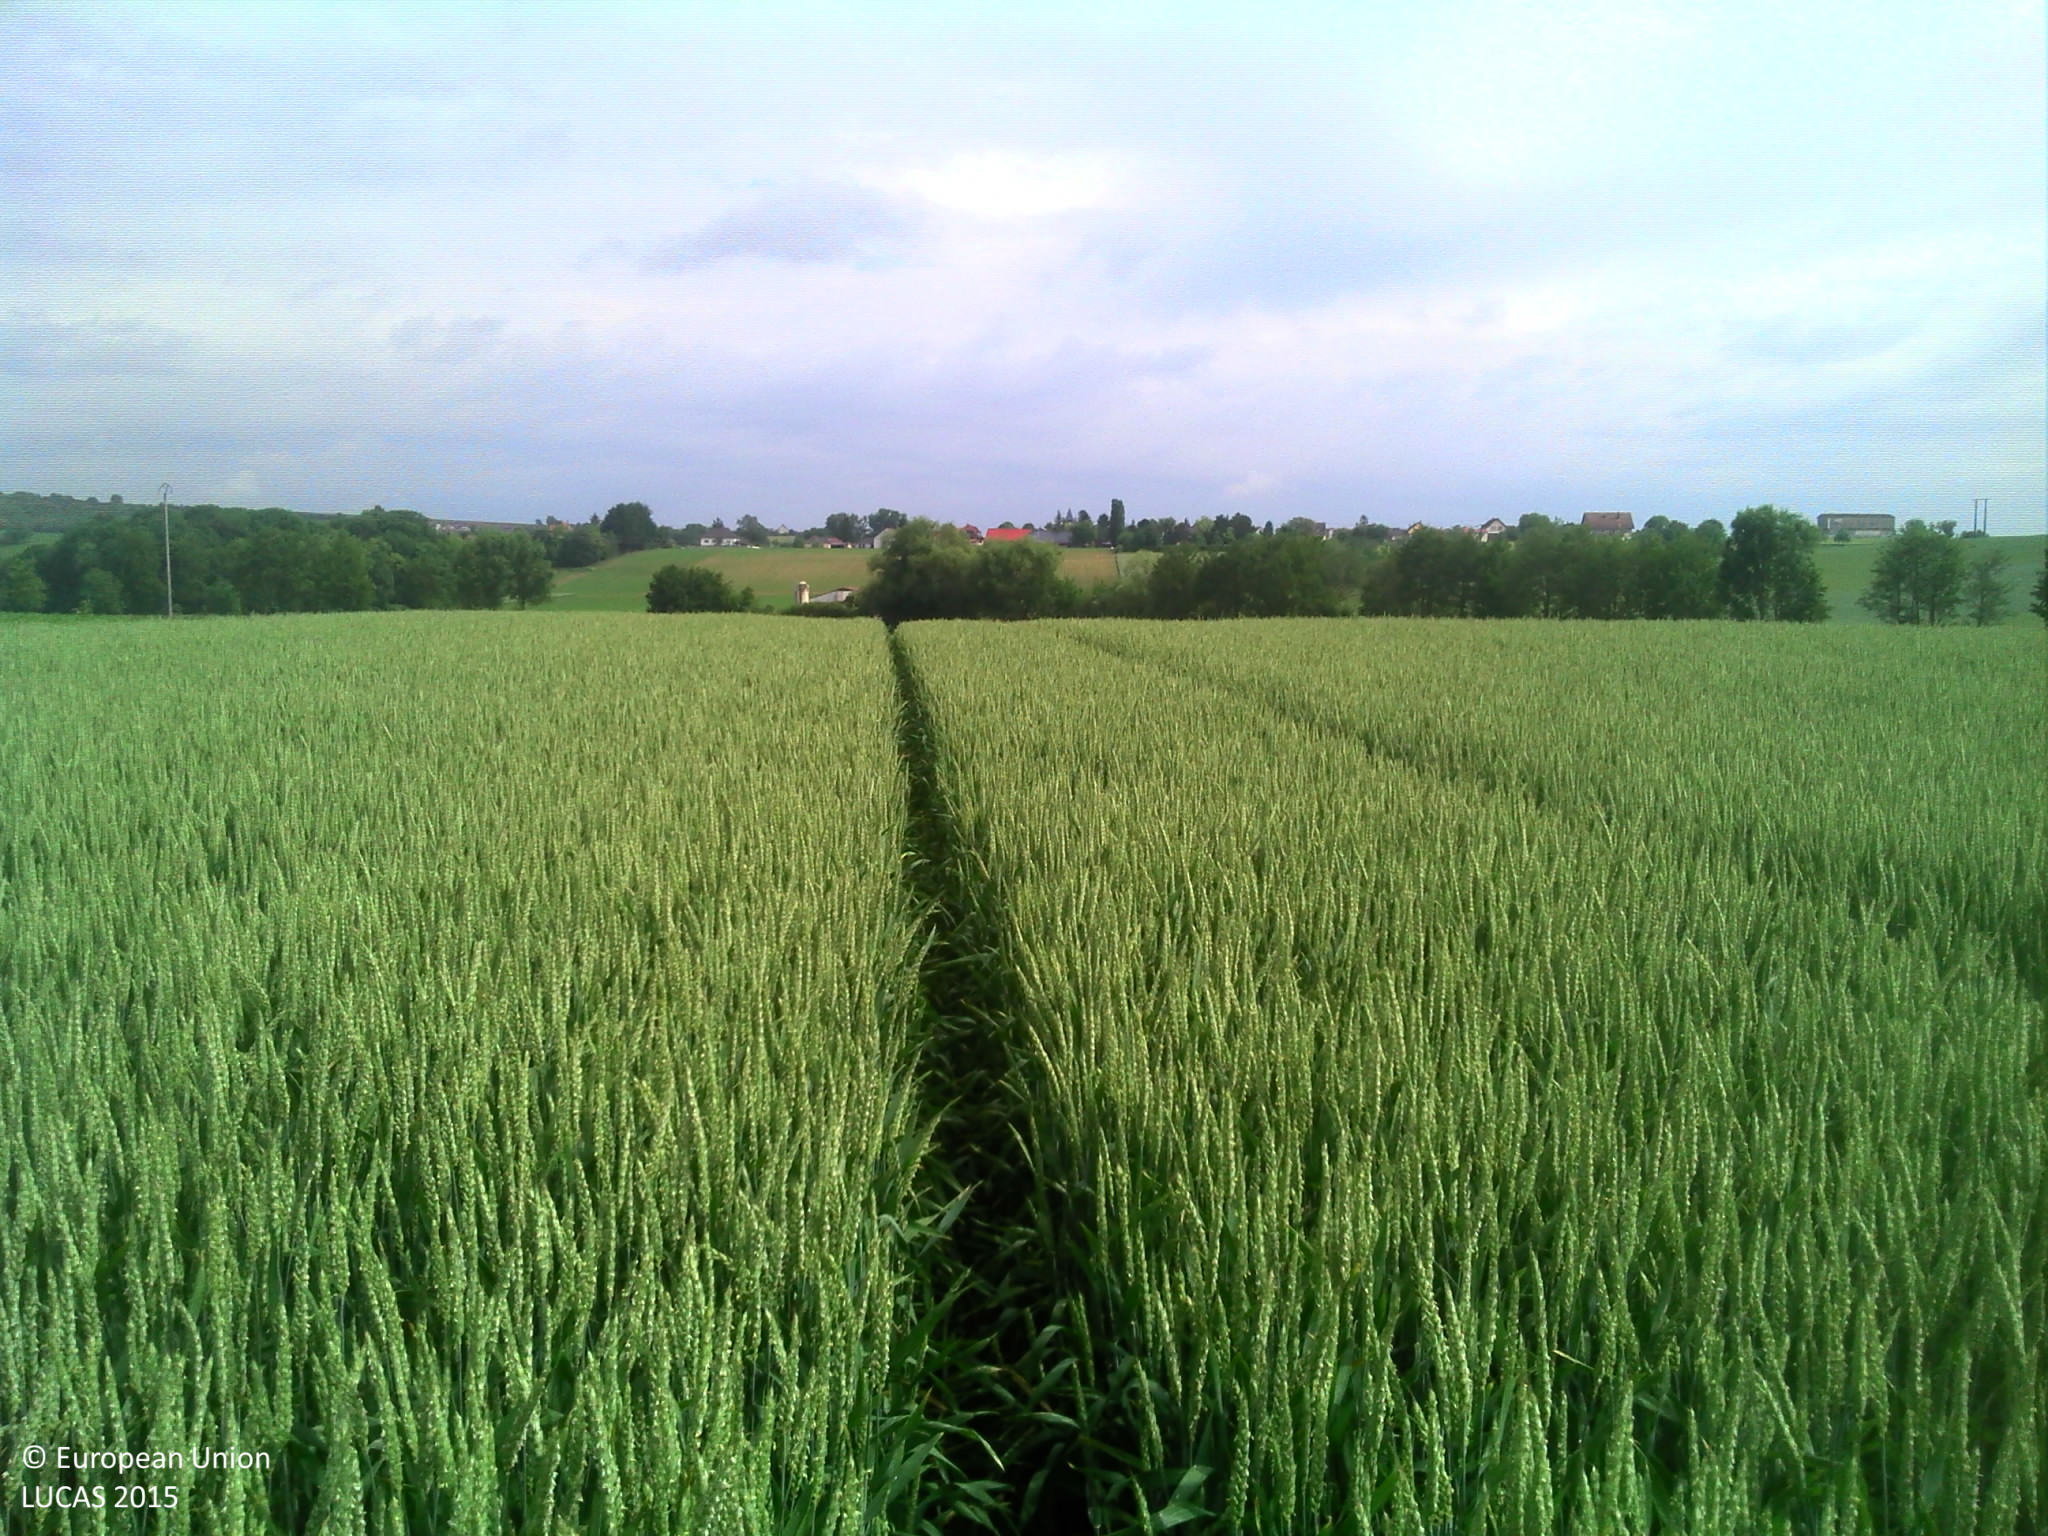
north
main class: Cropland
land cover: Common wheat
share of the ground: > 75 %
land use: Agriculture (excluding fallow land and kitchen gardens)
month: May
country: FR
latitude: 48.6462
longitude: 7.5441
